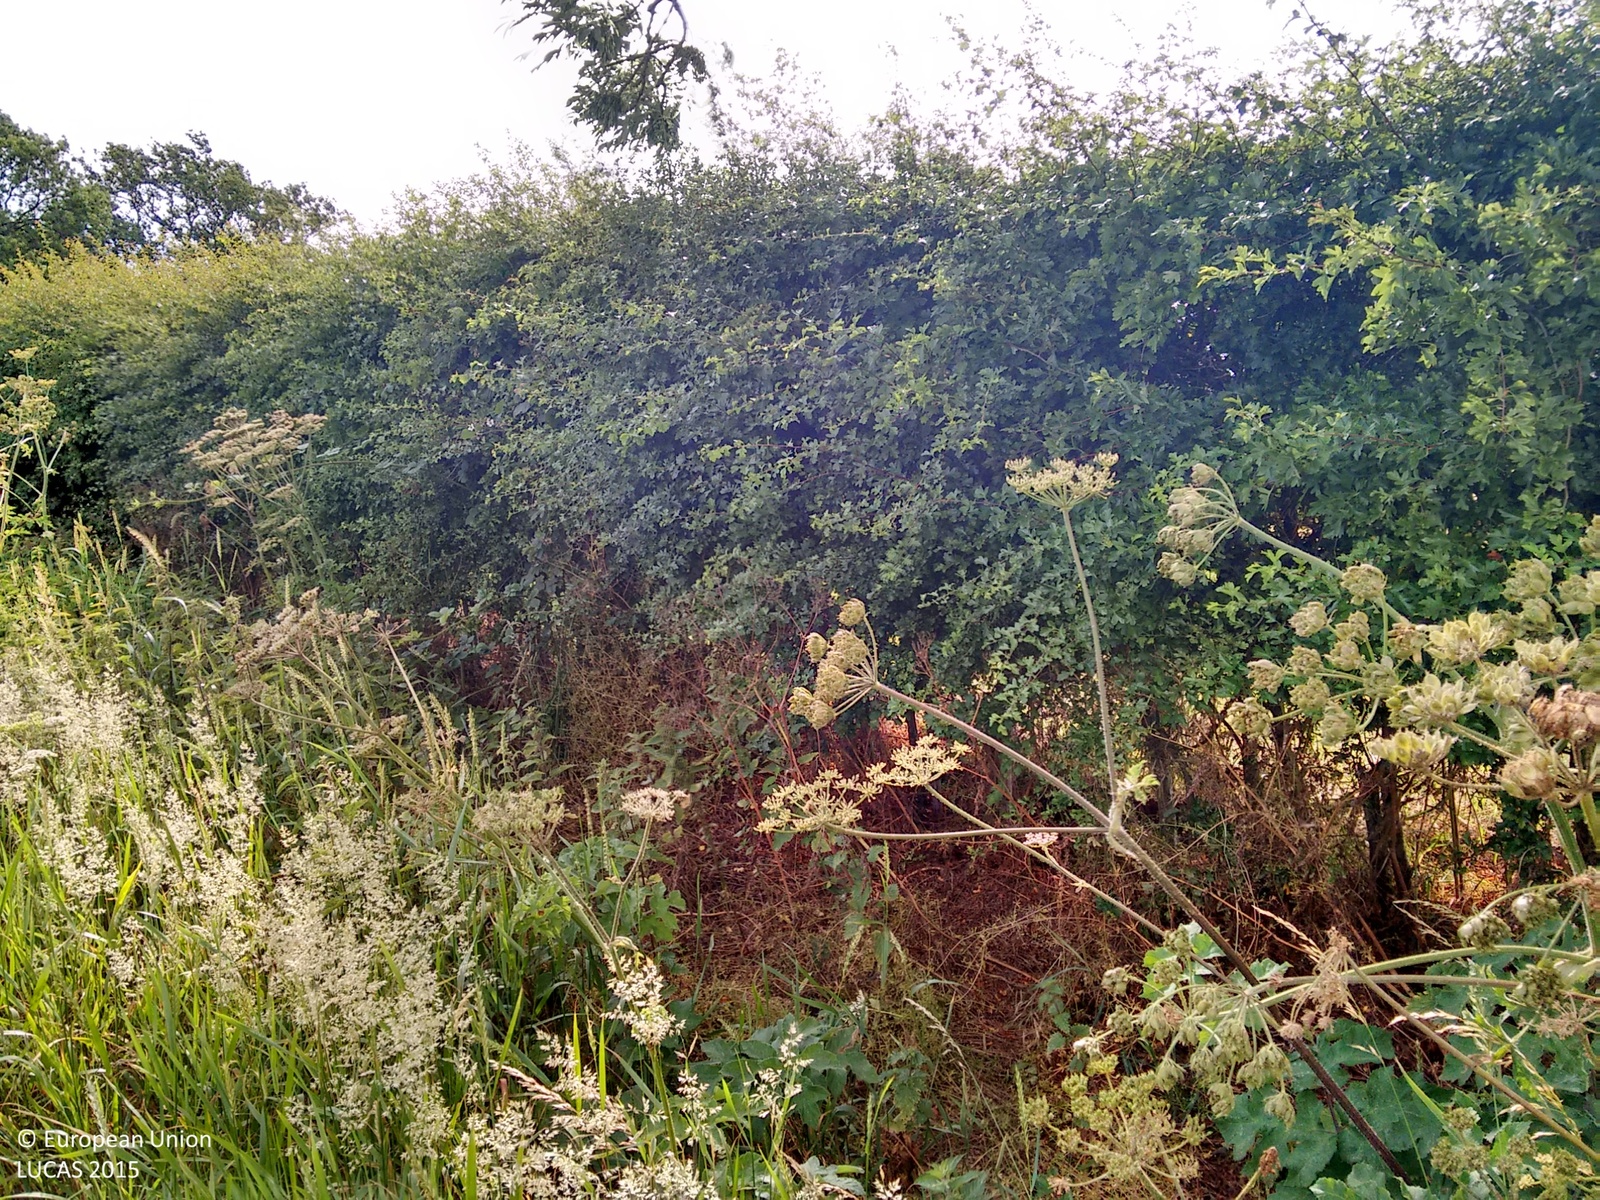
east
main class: Cropland
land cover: Common wheat
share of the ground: > 75 %
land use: Agriculture (excluding fallow land and kitchen gardens)
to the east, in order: Common wheat; Grass margins; Managed hedges; Tracks; Common wheat; Grass margins; Managed hedges; Grass margins; Tracks; Broadleaved woodland; Rape and turnip rape
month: July
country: GB
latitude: 52.6136
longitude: -0.7485
